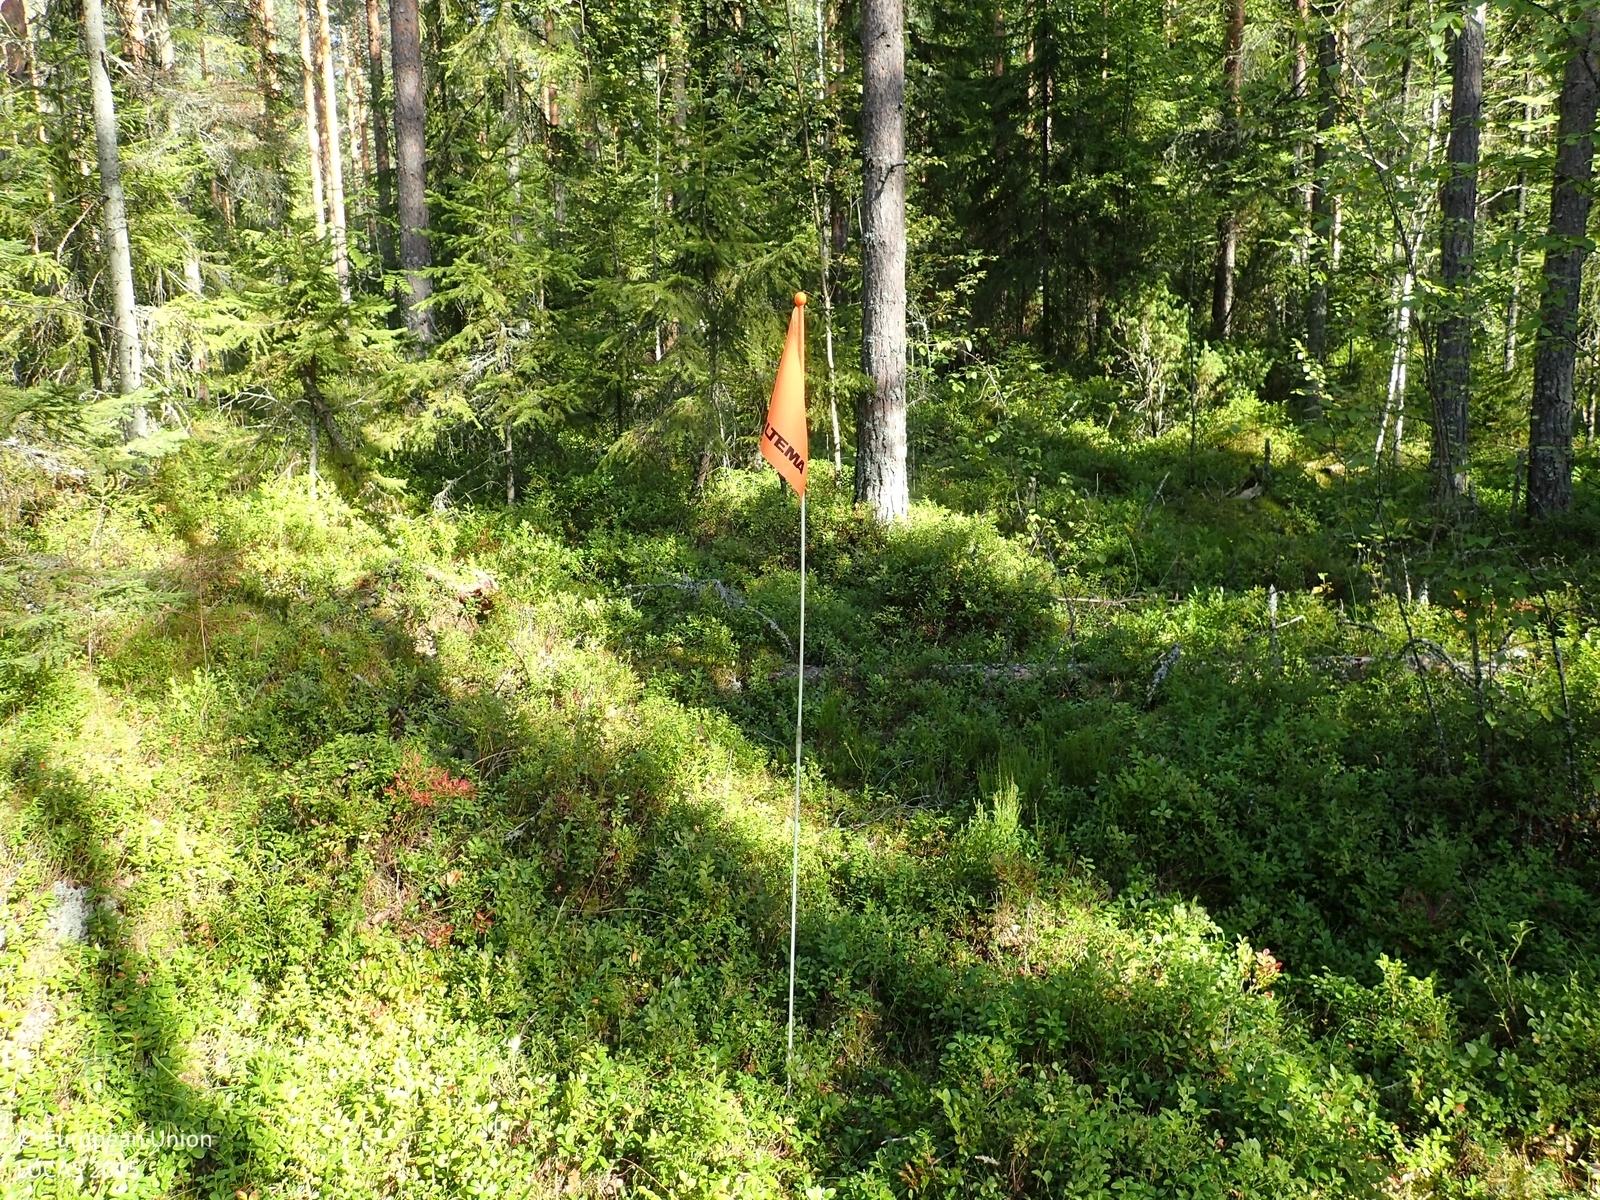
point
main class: Woodland
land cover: Other coniferous woodland
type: boreal forest
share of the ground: > 75 %
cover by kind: coniferous forest trees 65 %, shrubs 20 %, broadleaved forest trees 10 %, lichens and mosses 5 %
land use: Forestry
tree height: > 5 m
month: August
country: FI
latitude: 62.6494
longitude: 22.3636
